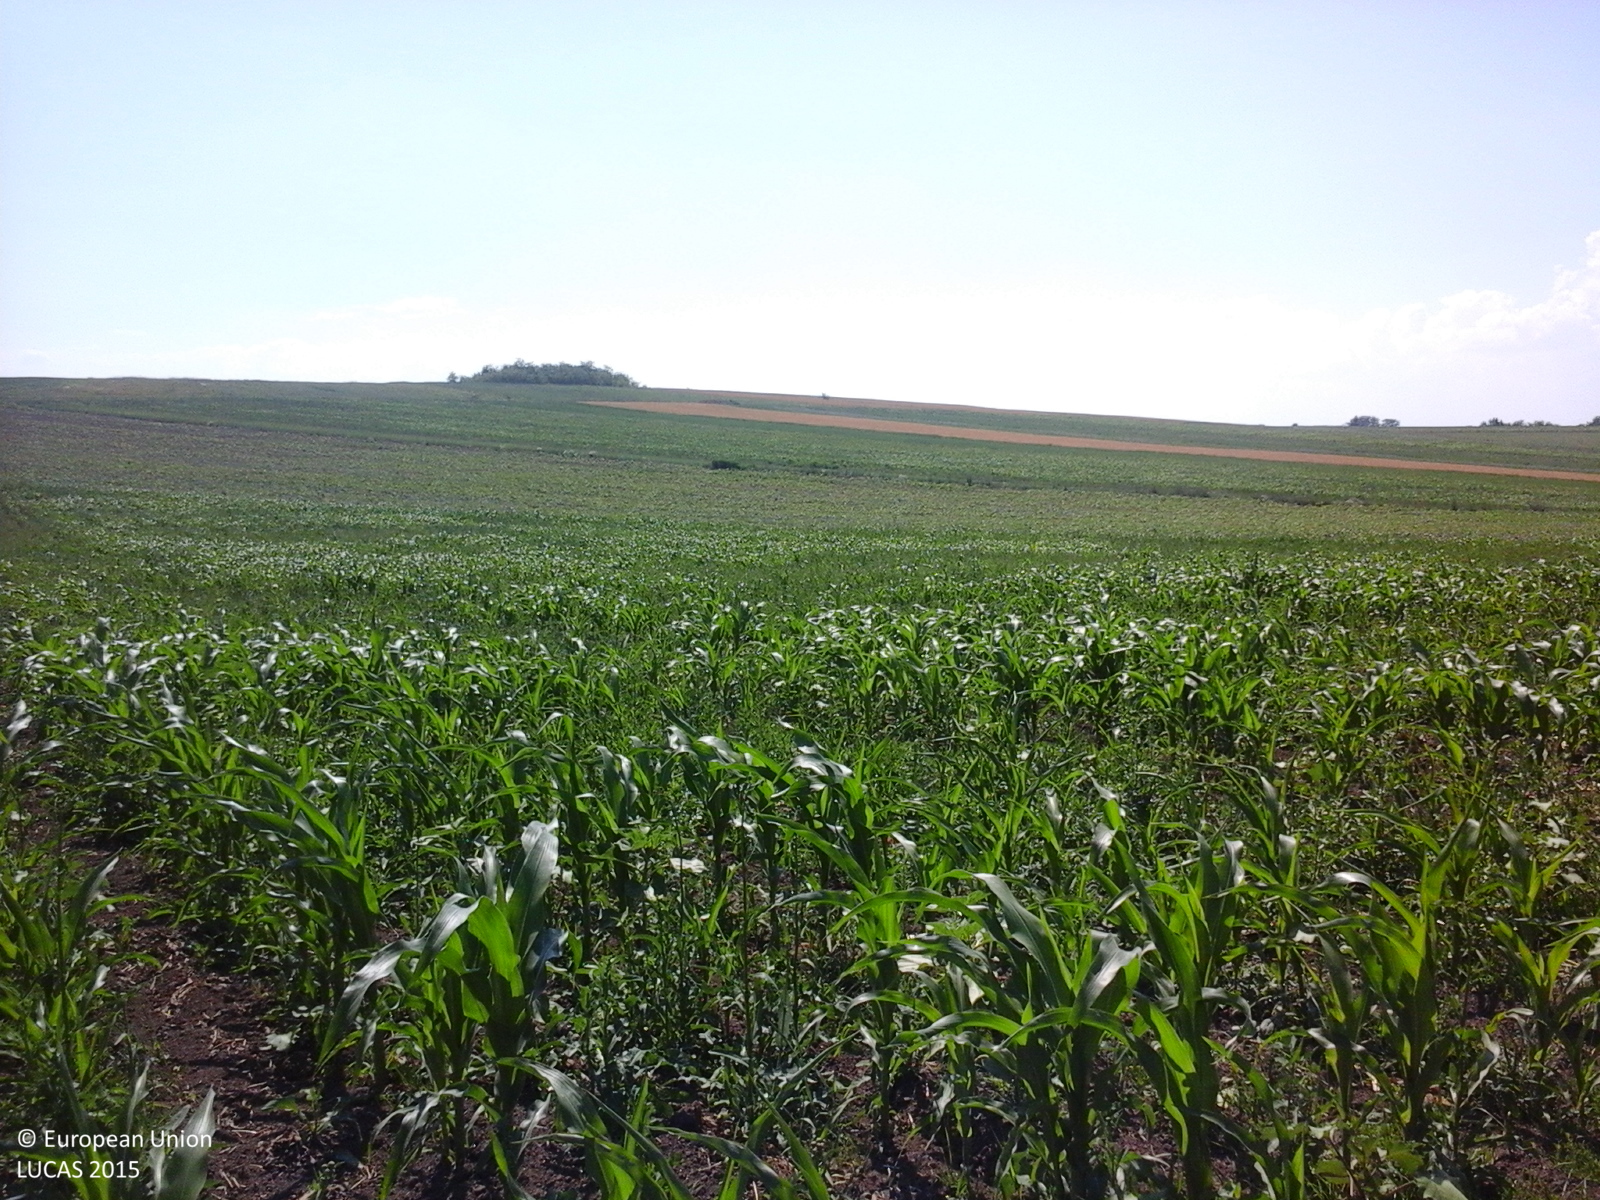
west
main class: Cropland
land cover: Maize
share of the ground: 25 - 50 %
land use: Agriculture (excluding fallow land and kitchen gardens)
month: June
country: RO
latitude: 47.0057
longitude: 27.0820
